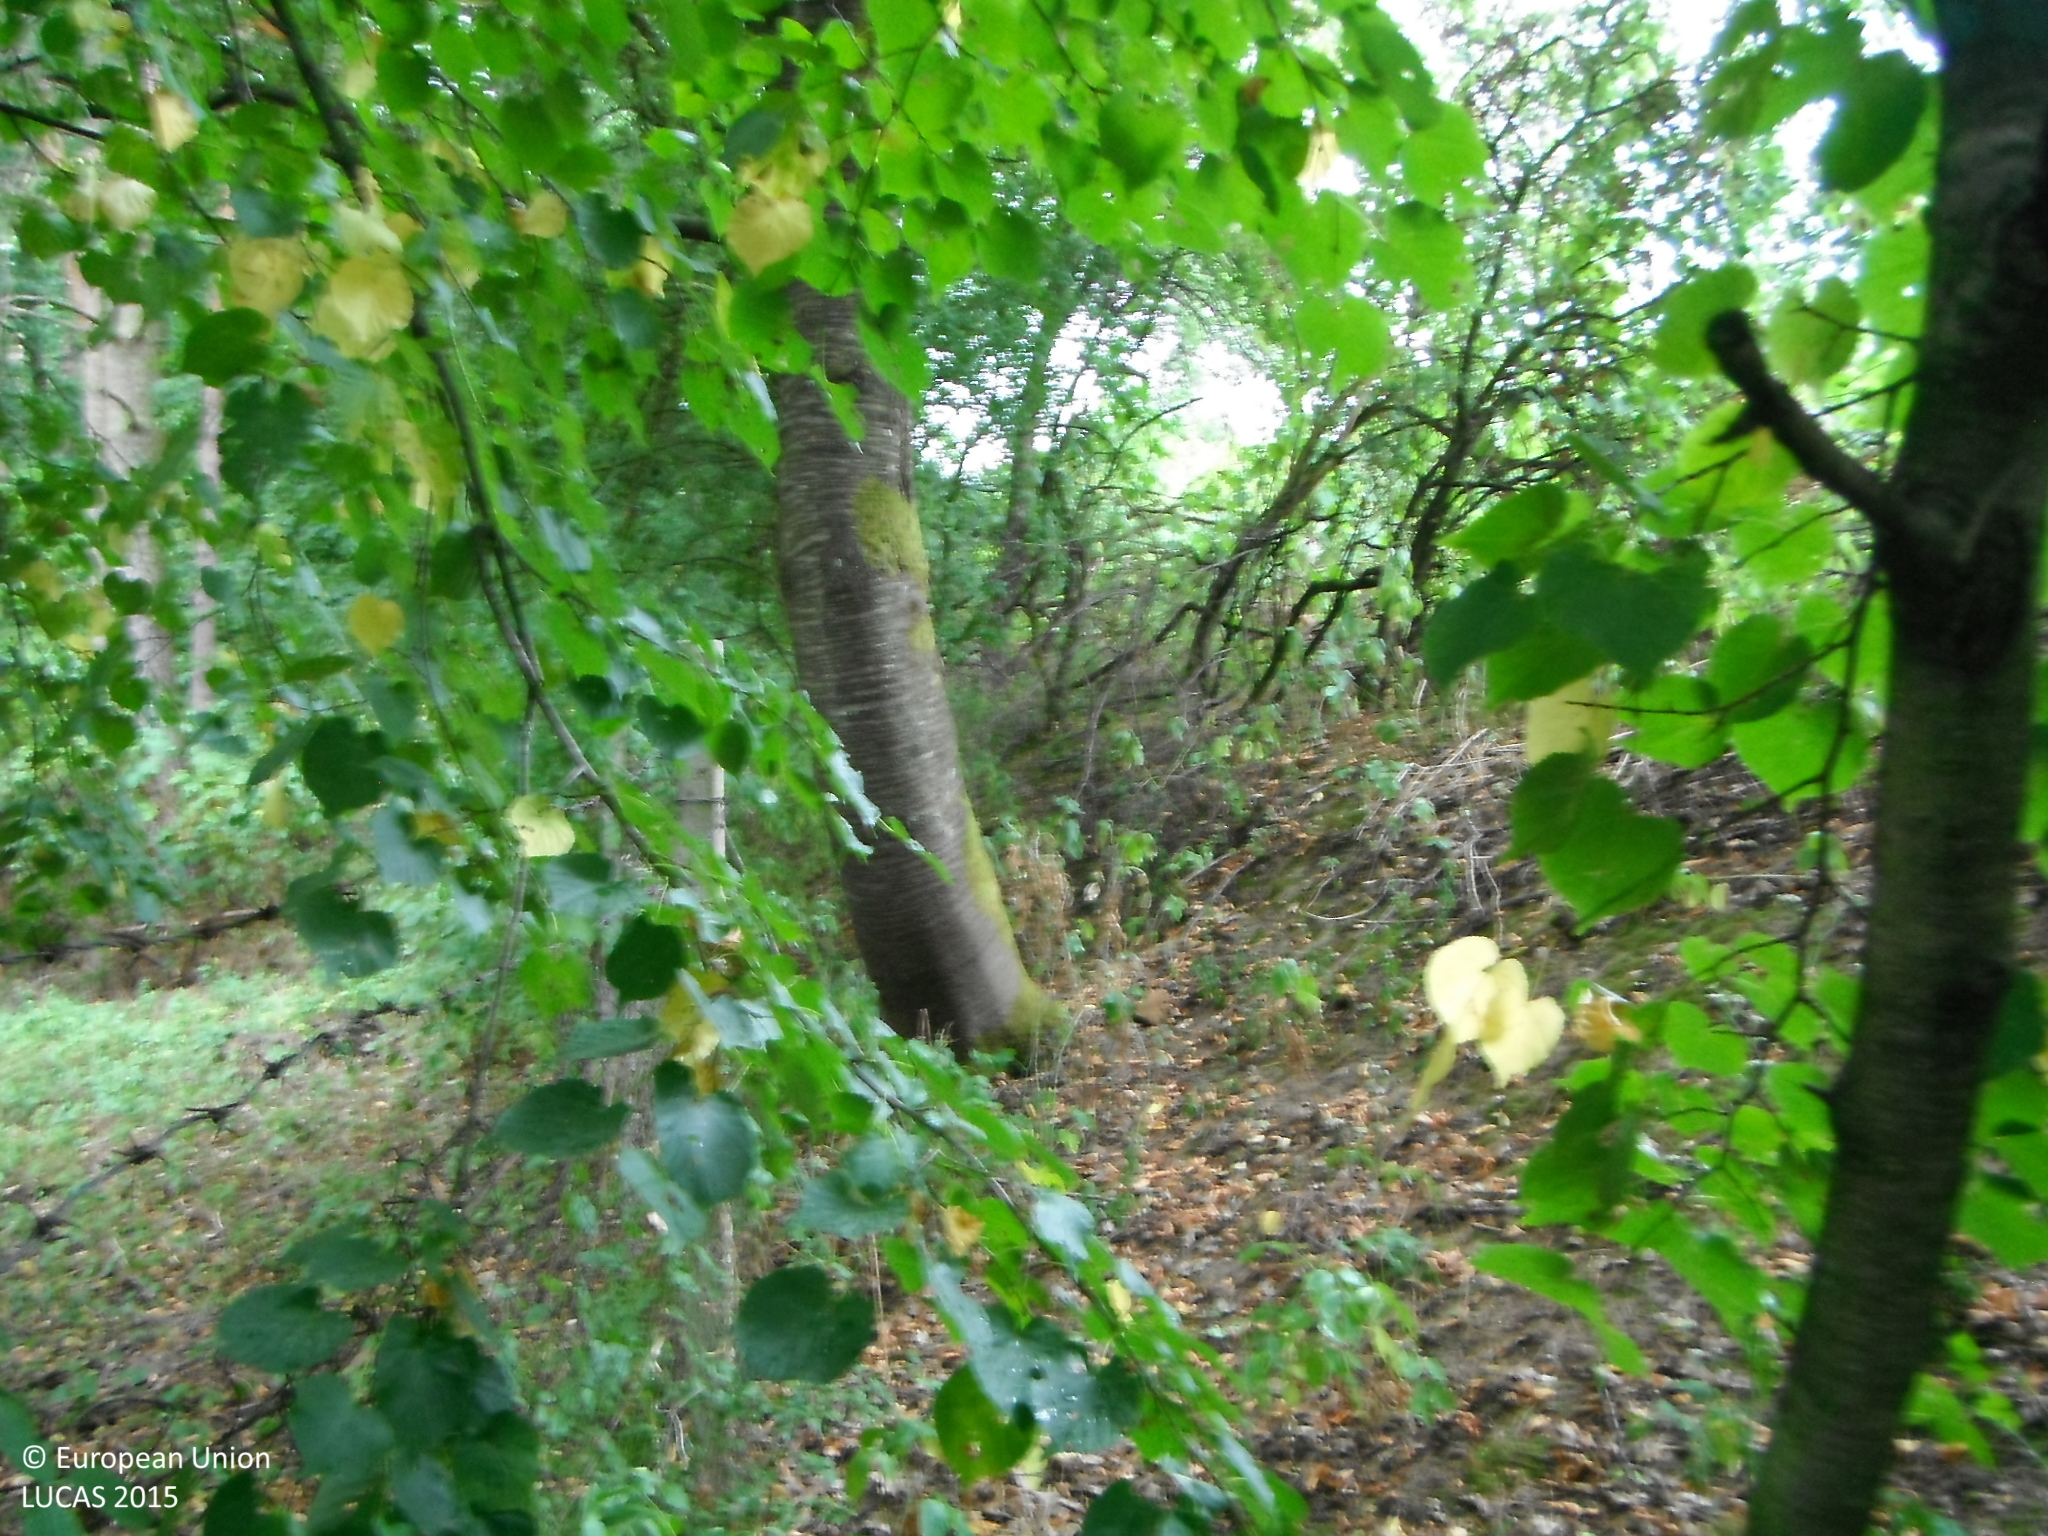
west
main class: Woodland
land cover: Broadleaved woodland
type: mesophytic deciduous forest
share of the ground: > 75 %
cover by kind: broadleaved forest trees 80 %, herbaceous plants 20 %
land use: Forestry
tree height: > 5 m
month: July
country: SK
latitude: 48.6809
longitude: 18.1505
